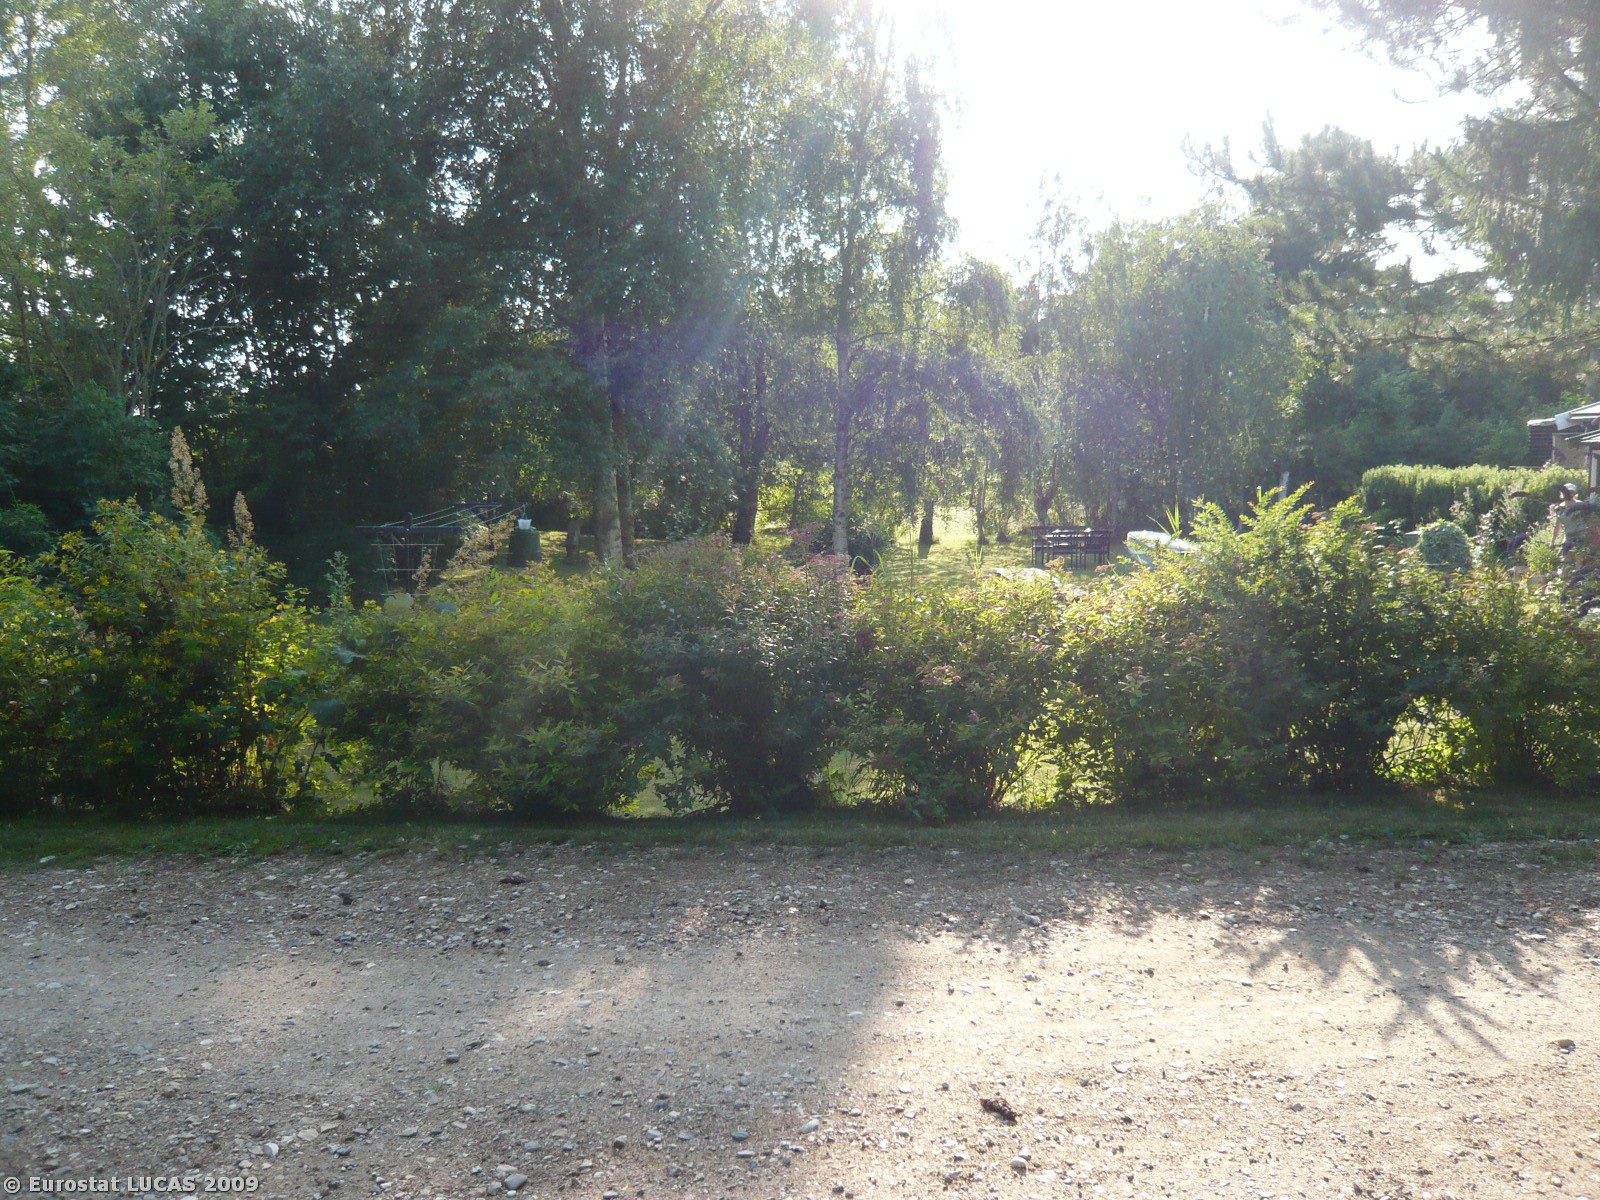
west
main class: Woodland
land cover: Coniferous woodland
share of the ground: > 75 %
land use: Holiday camps
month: July
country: DK
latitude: 55.7997
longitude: 11.6415
